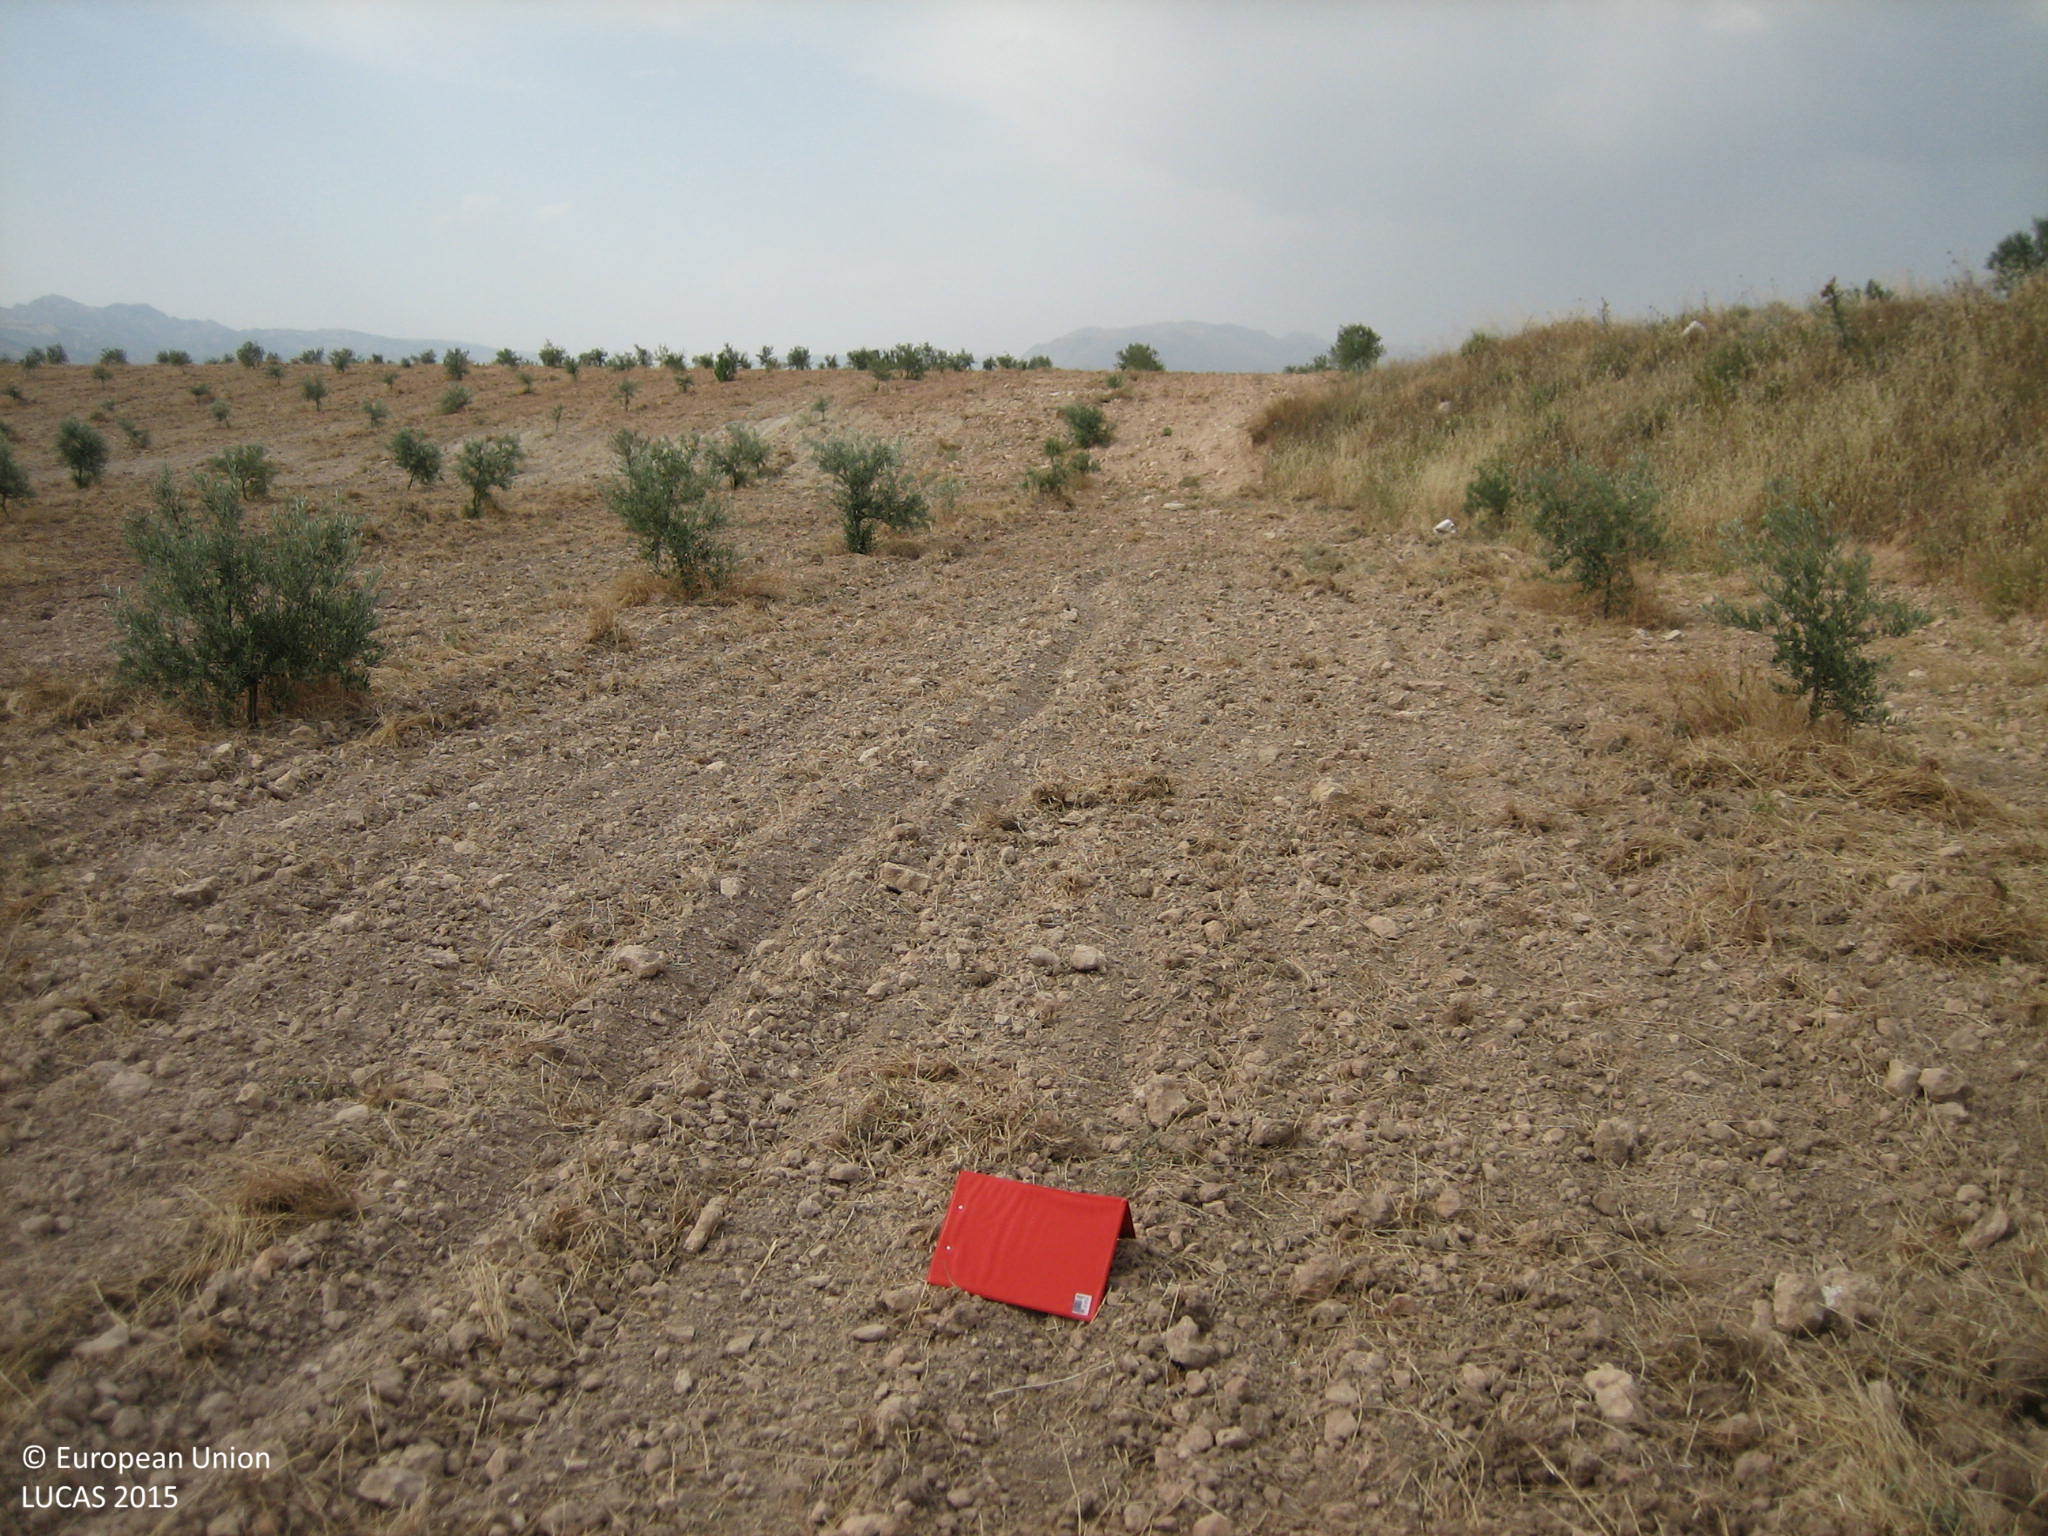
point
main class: Cropland
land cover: Olive groves
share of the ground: < 10 %
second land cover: Other bare soil
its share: > 75 %
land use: Agriculture (excluding fallow land and kitchen gardens)
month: July
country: ES
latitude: 37.6355
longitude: -2.8974
